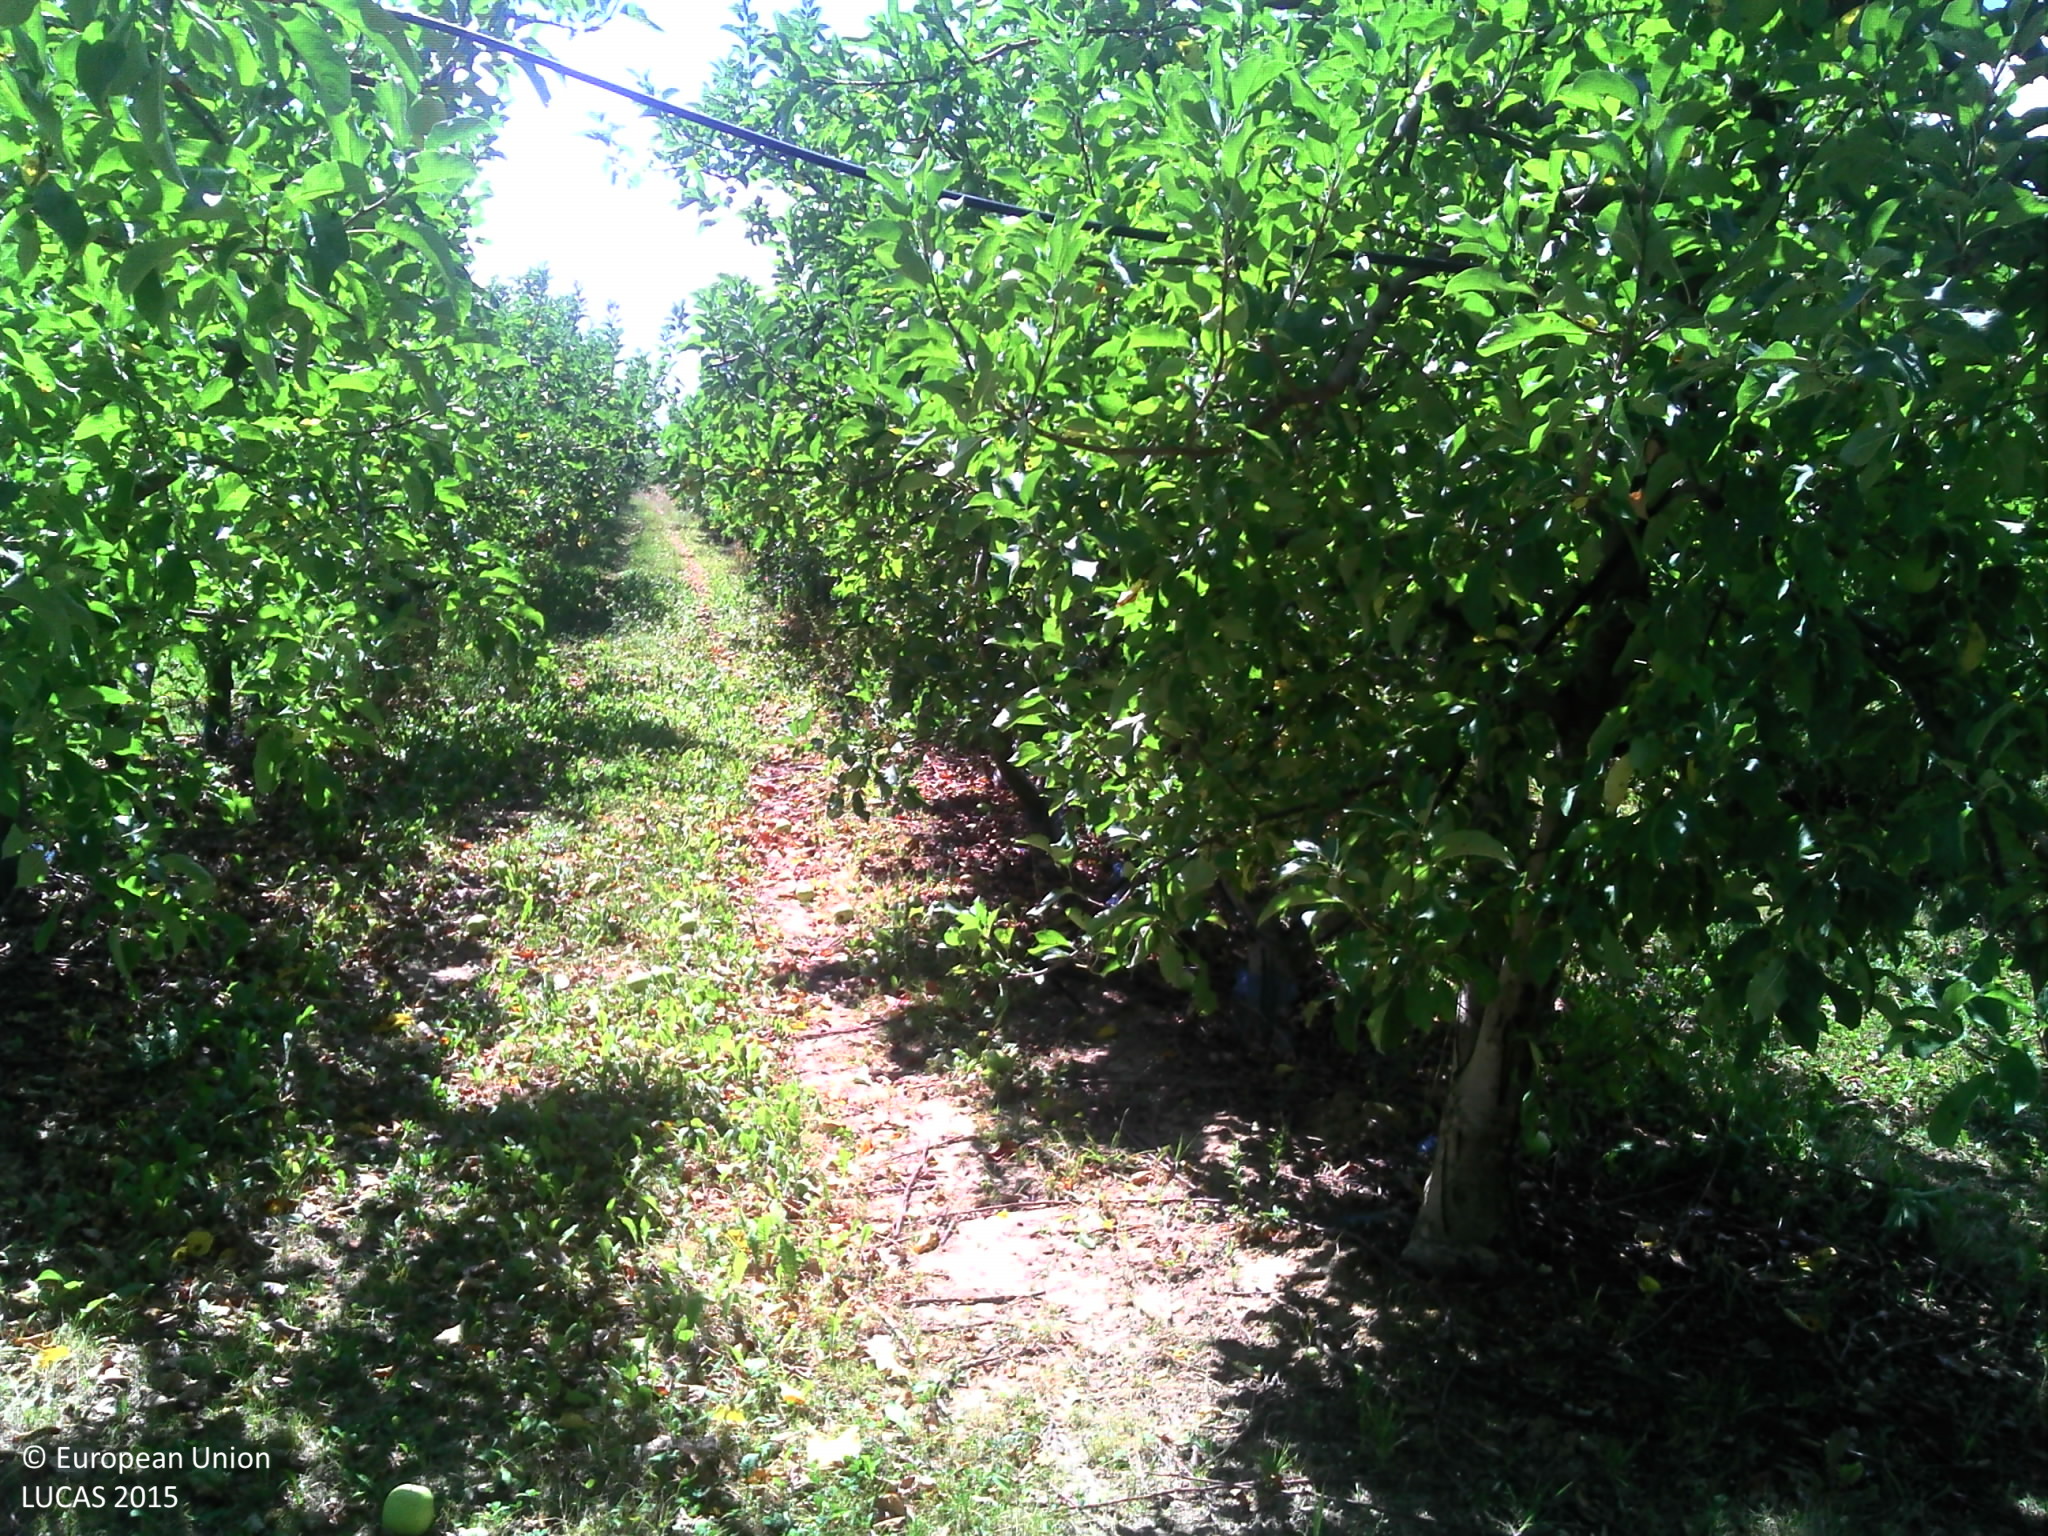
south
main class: Woodland
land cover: Broadleaved woodland
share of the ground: > 75 %
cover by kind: broadleaved forest trees 90 %, herbaceous plants 10 %
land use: Semi-natural and natural areas not in use
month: August
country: FR
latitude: 45.3369
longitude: 4.7343
